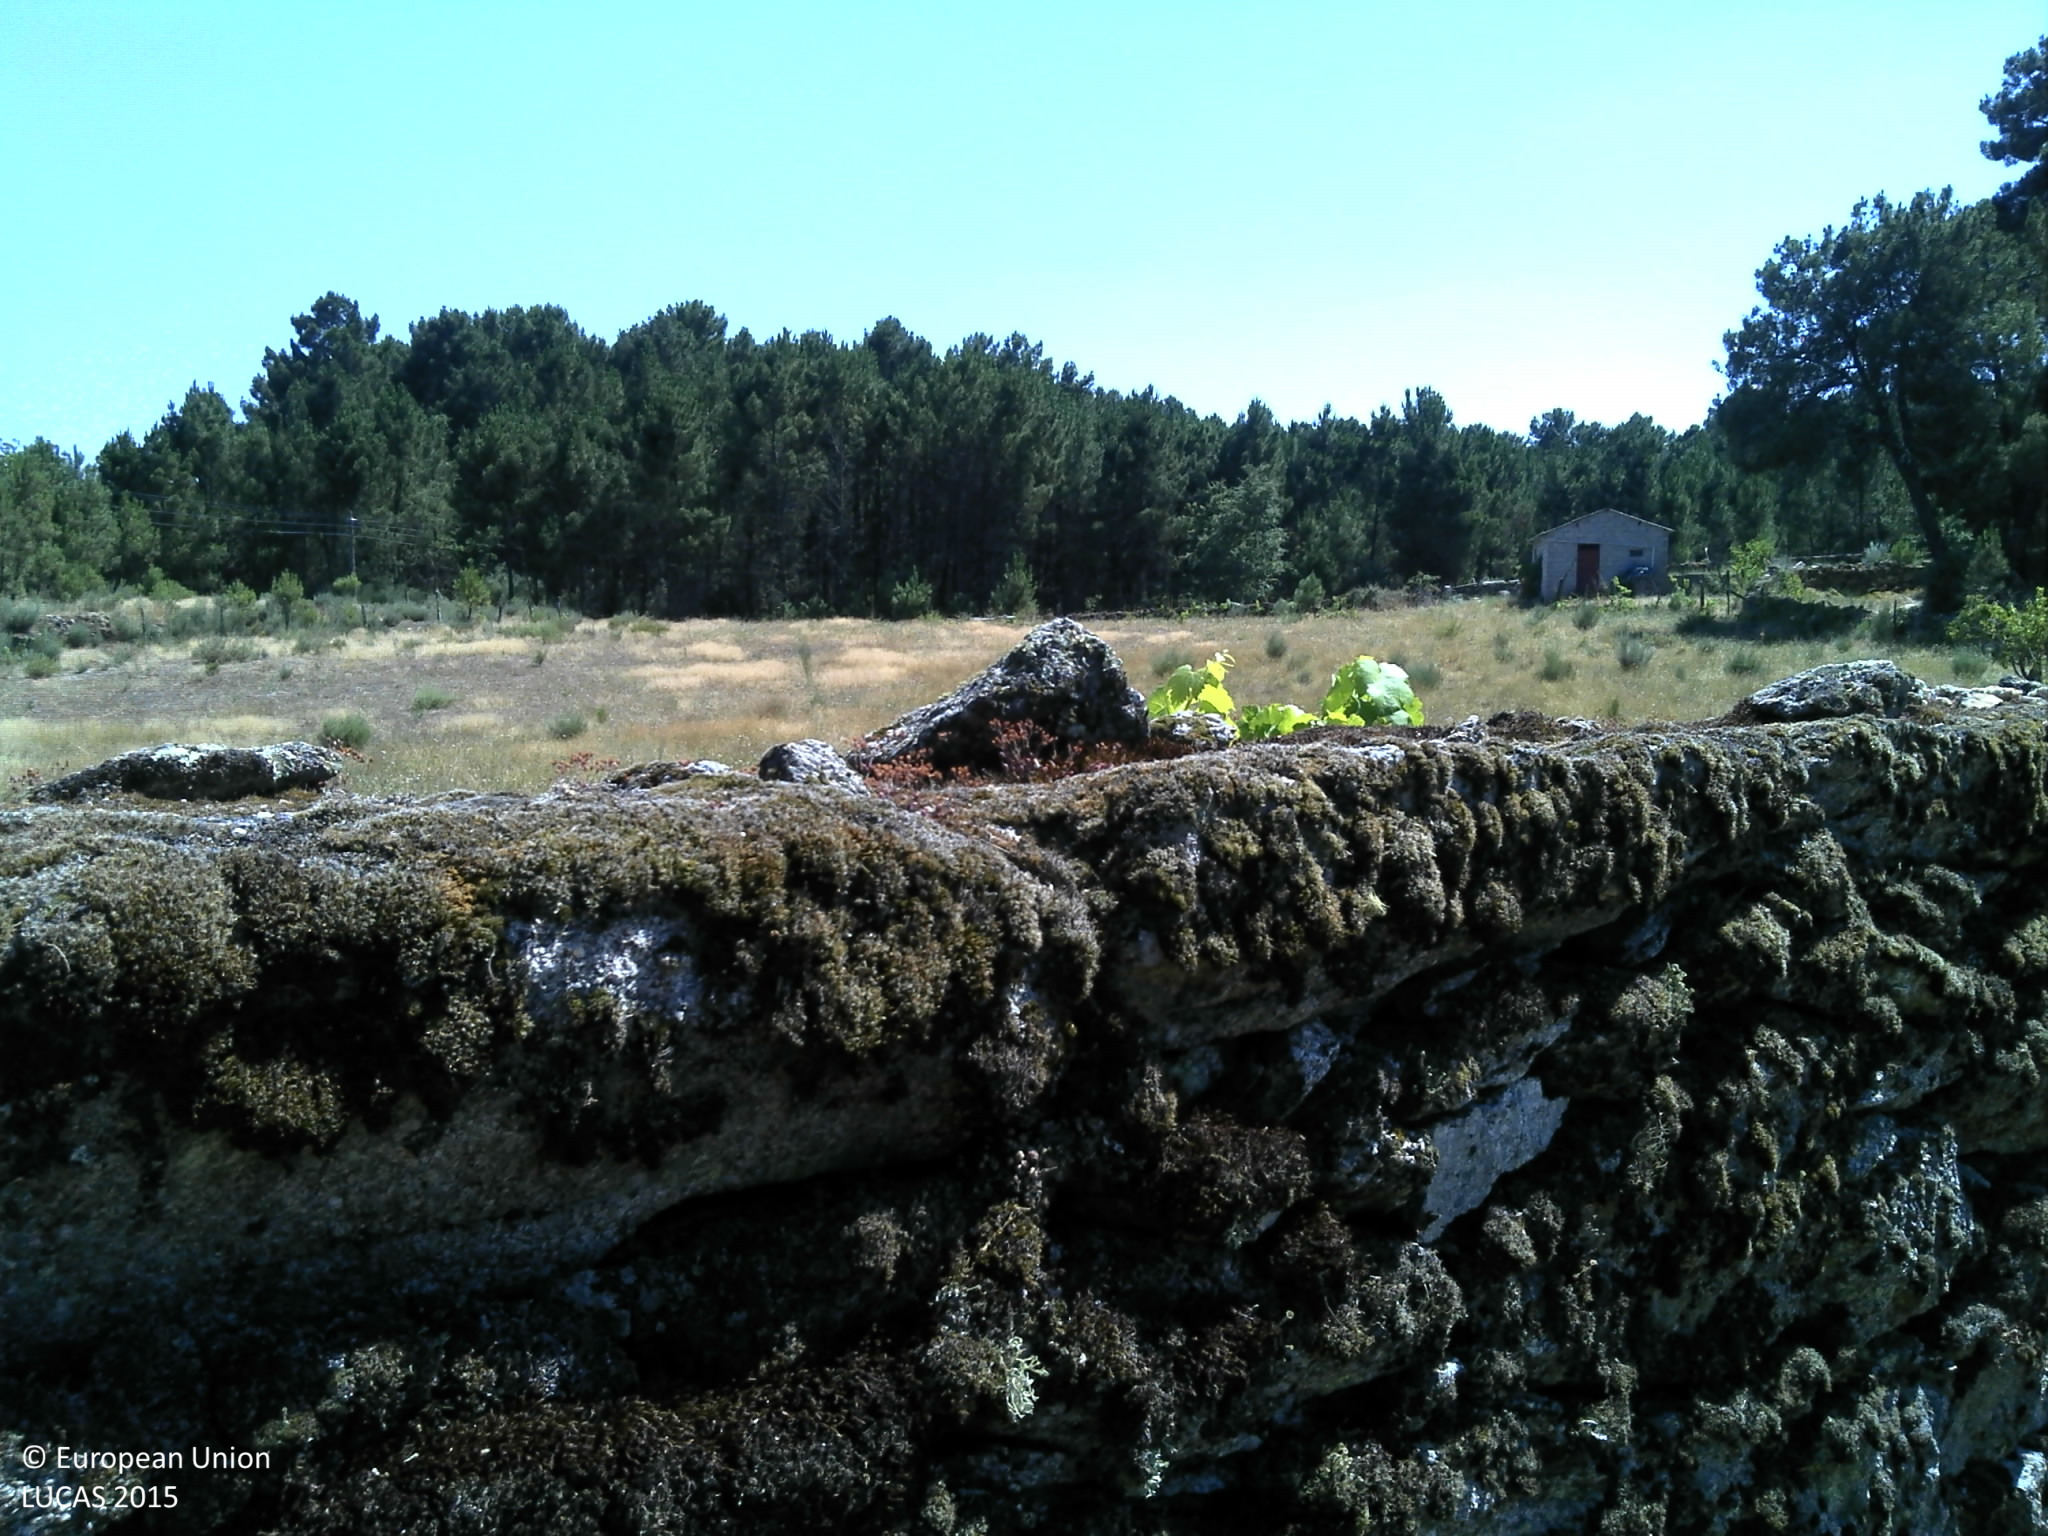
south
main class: Grassland
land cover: Grassland without tree/shrub cover
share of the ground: > 75 %
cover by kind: herbaceous plants 75 %, unconsolidated bare surface 20 %, shrubs 5 %
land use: Abandoned areas
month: July
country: PT
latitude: 40.8372
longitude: -7.5146
